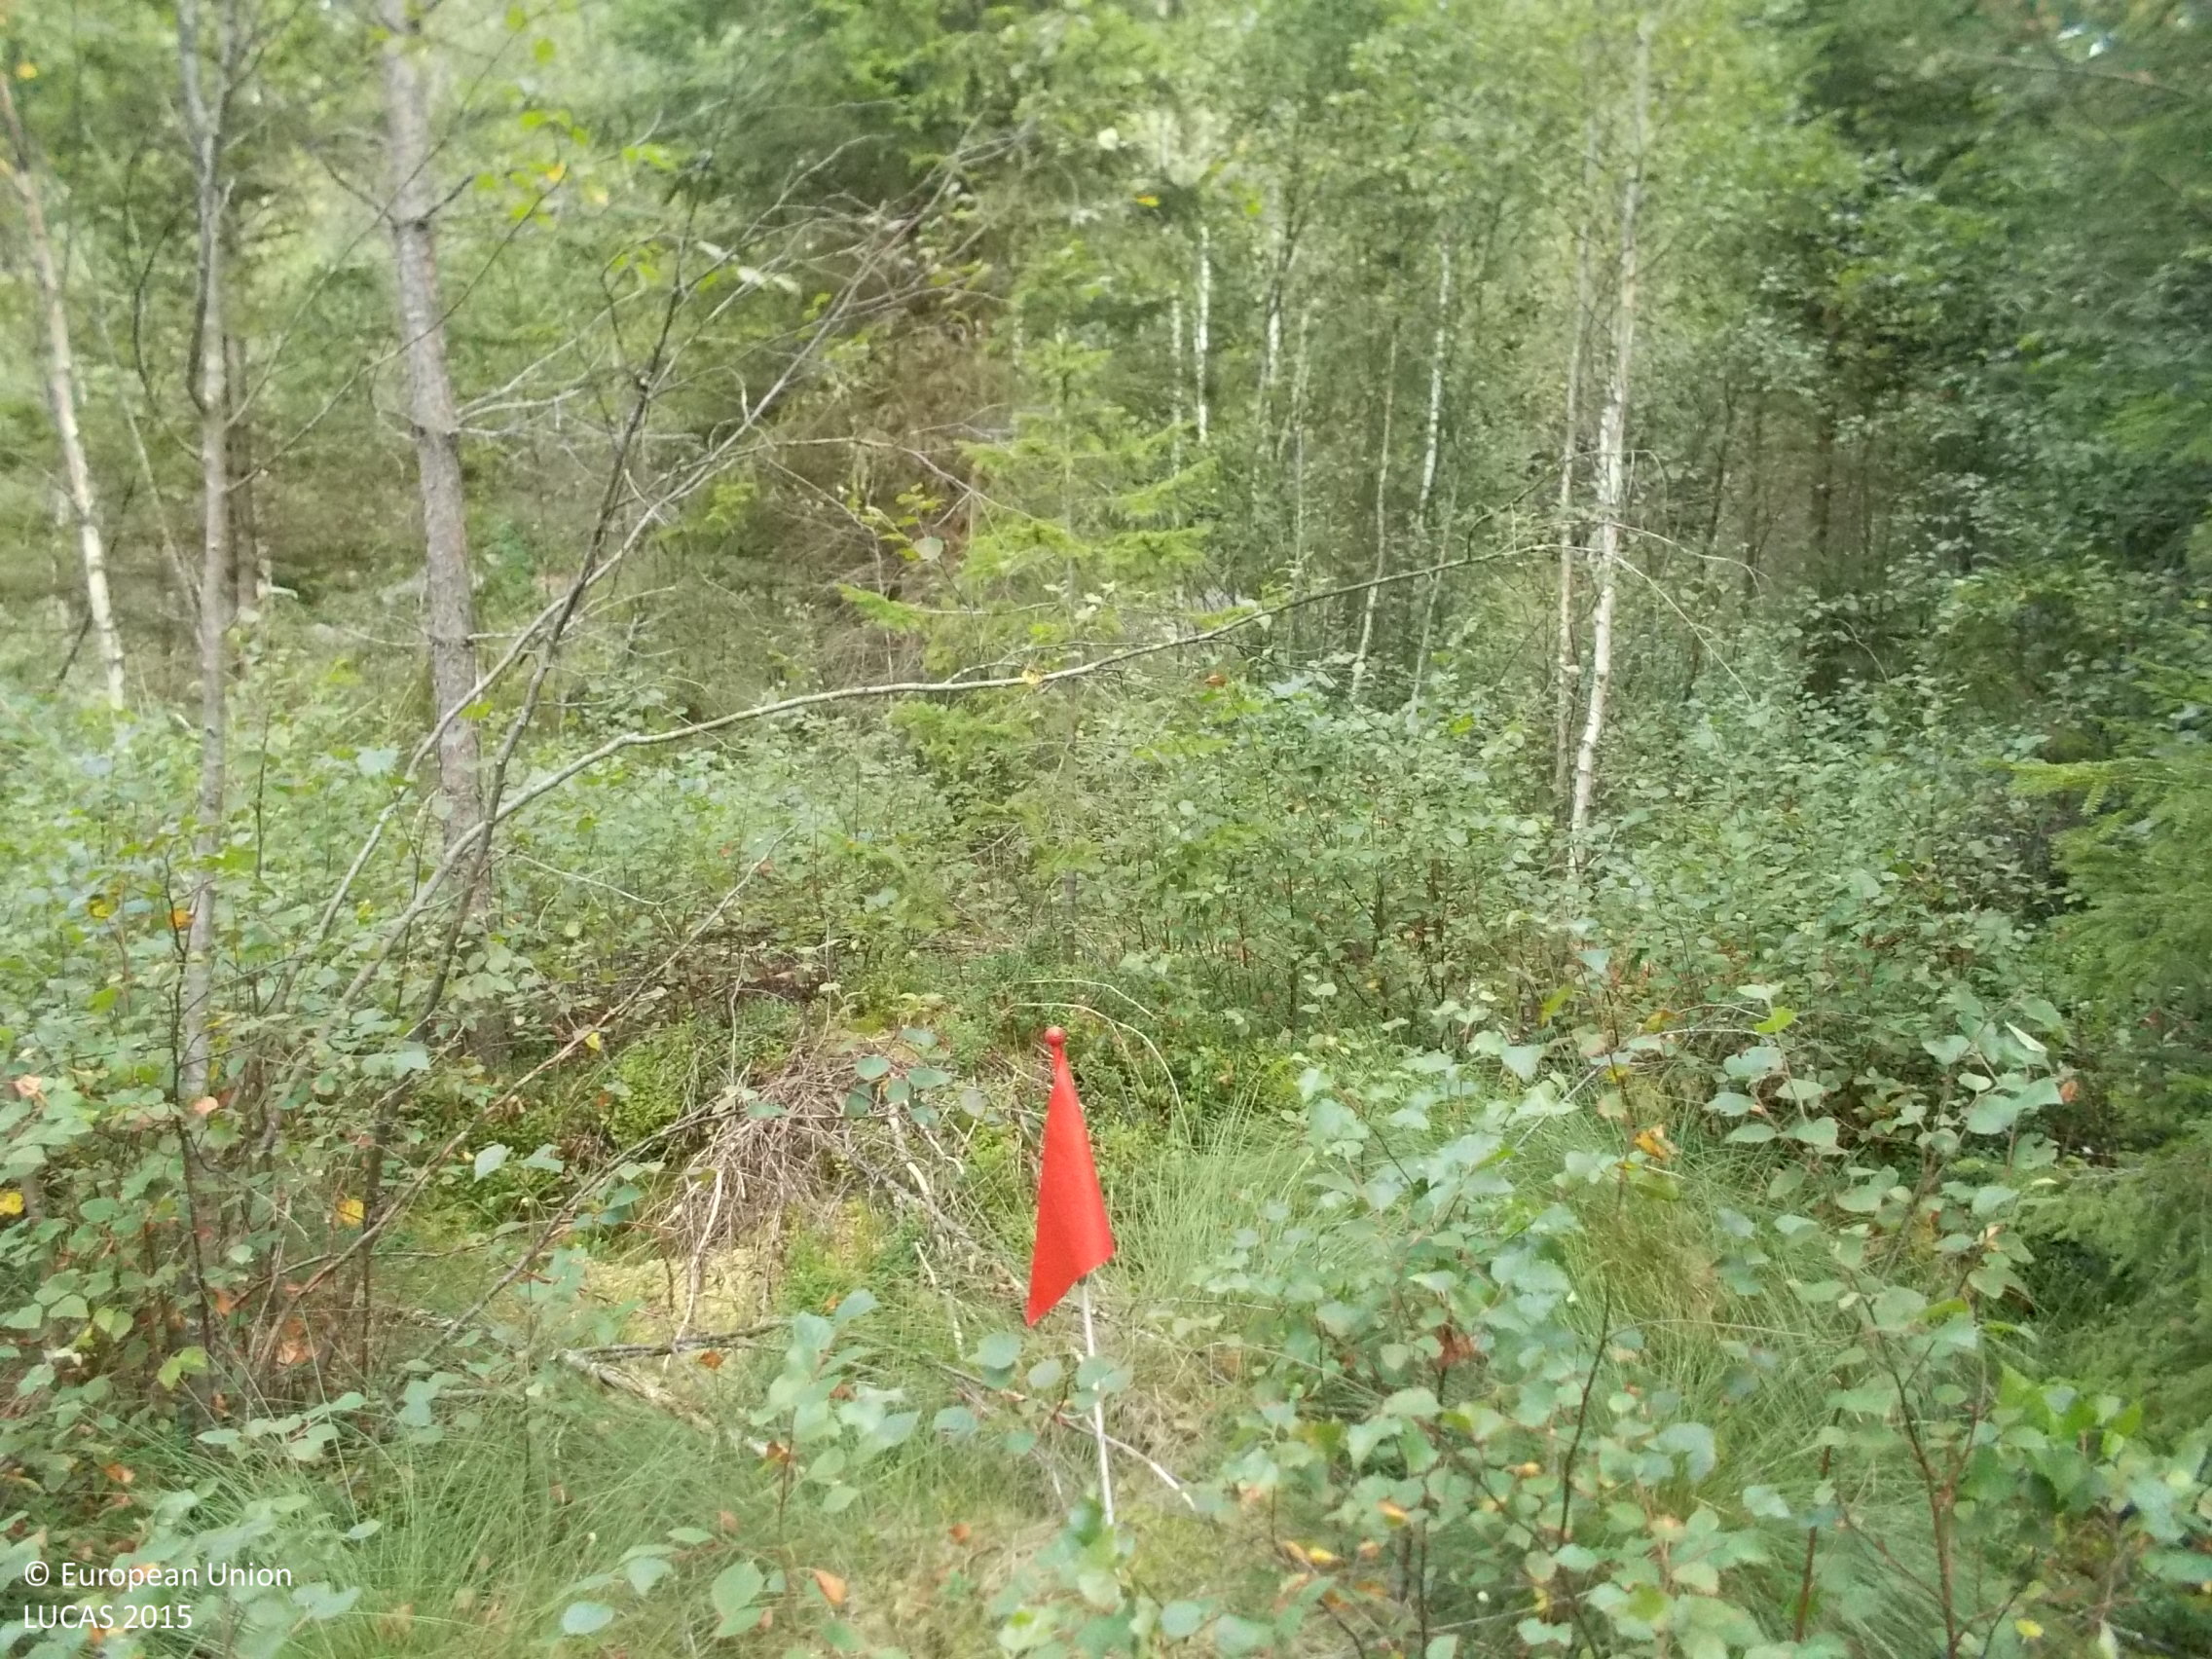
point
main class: Woodland
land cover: Spruce dominated mixed woodland
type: boreal forest
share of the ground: > 75 %
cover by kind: broadleaved forest trees 45 %, coniferous forest trees 40 %, shrubs 5 %, herbaceous plants 5 %, lichens and mosses 5 %
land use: Forestry
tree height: > 5 m
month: August
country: SE
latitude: 57.3893
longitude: 13.2068
